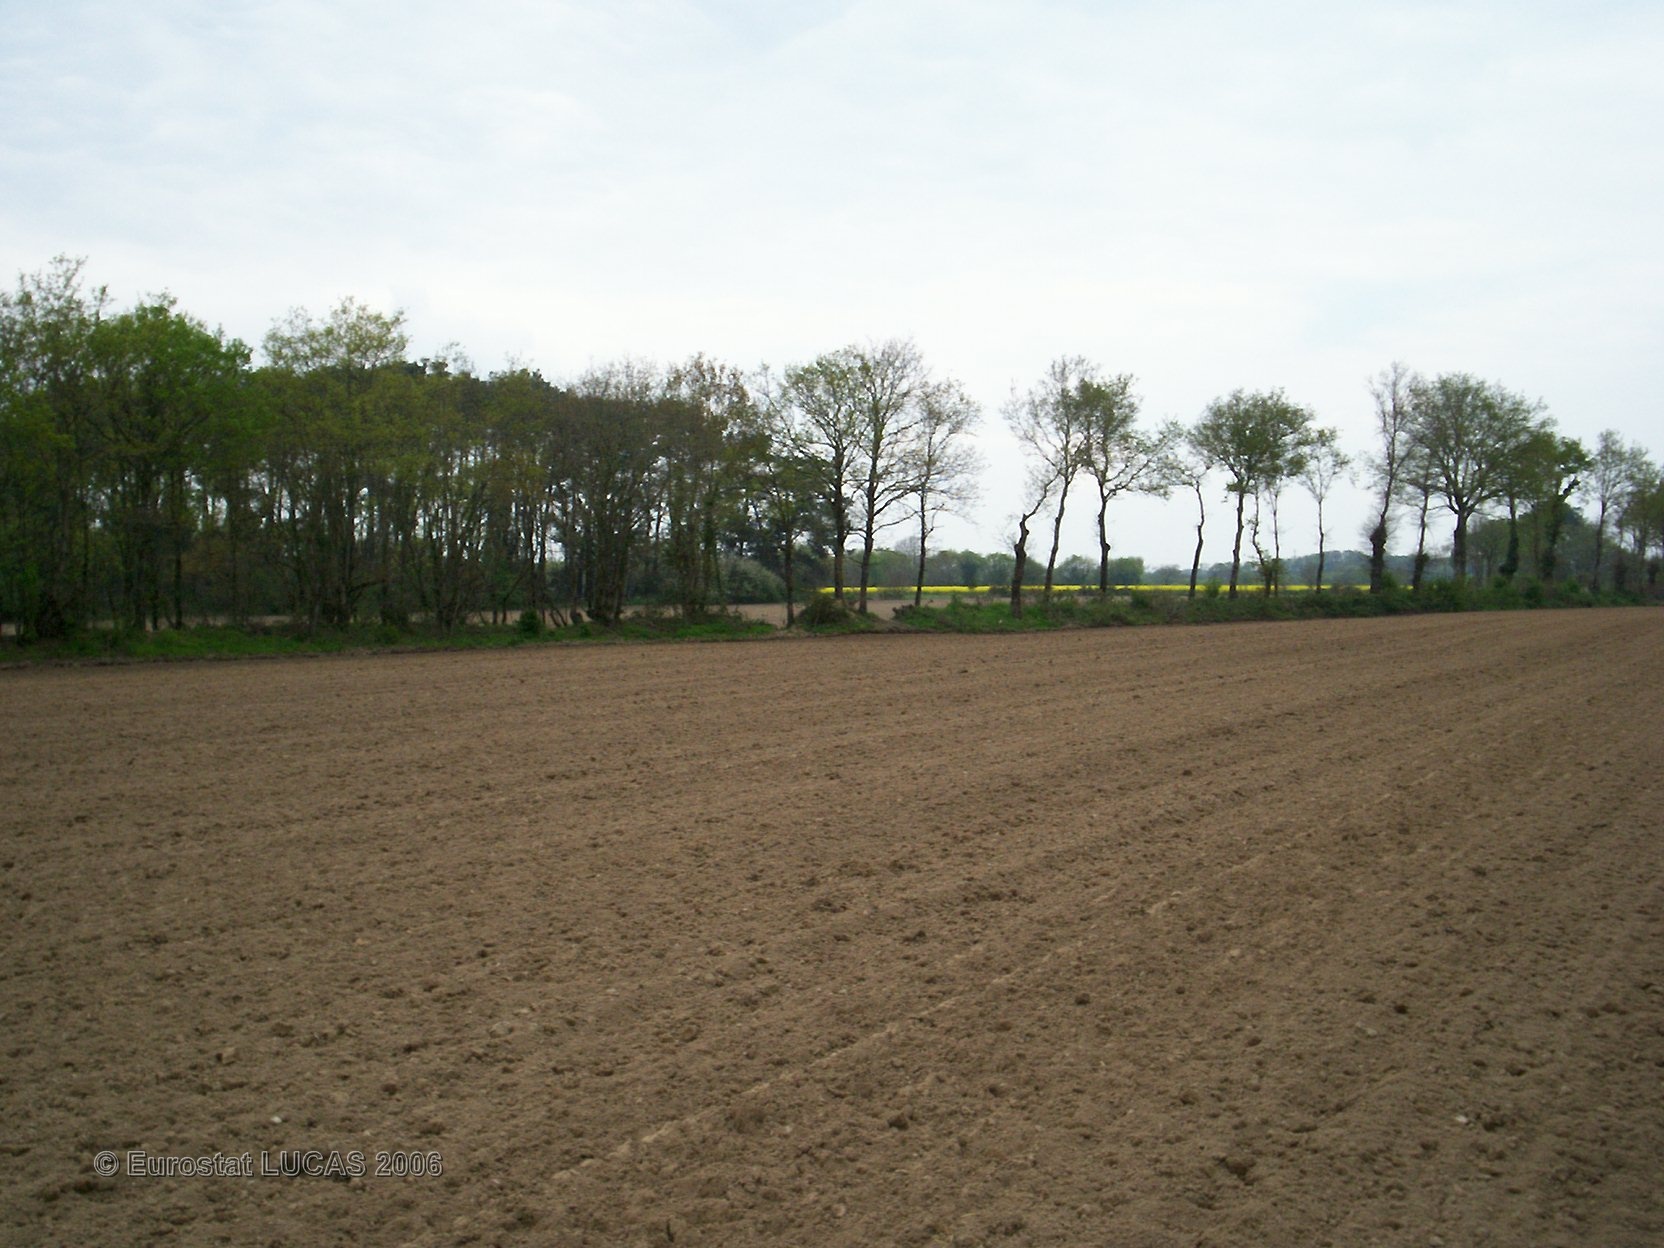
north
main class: Cropland
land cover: Maize
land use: Agriculture (excluding fallow land and kitchen gardens)
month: May
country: FR
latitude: 47.5615
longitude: -2.6729
